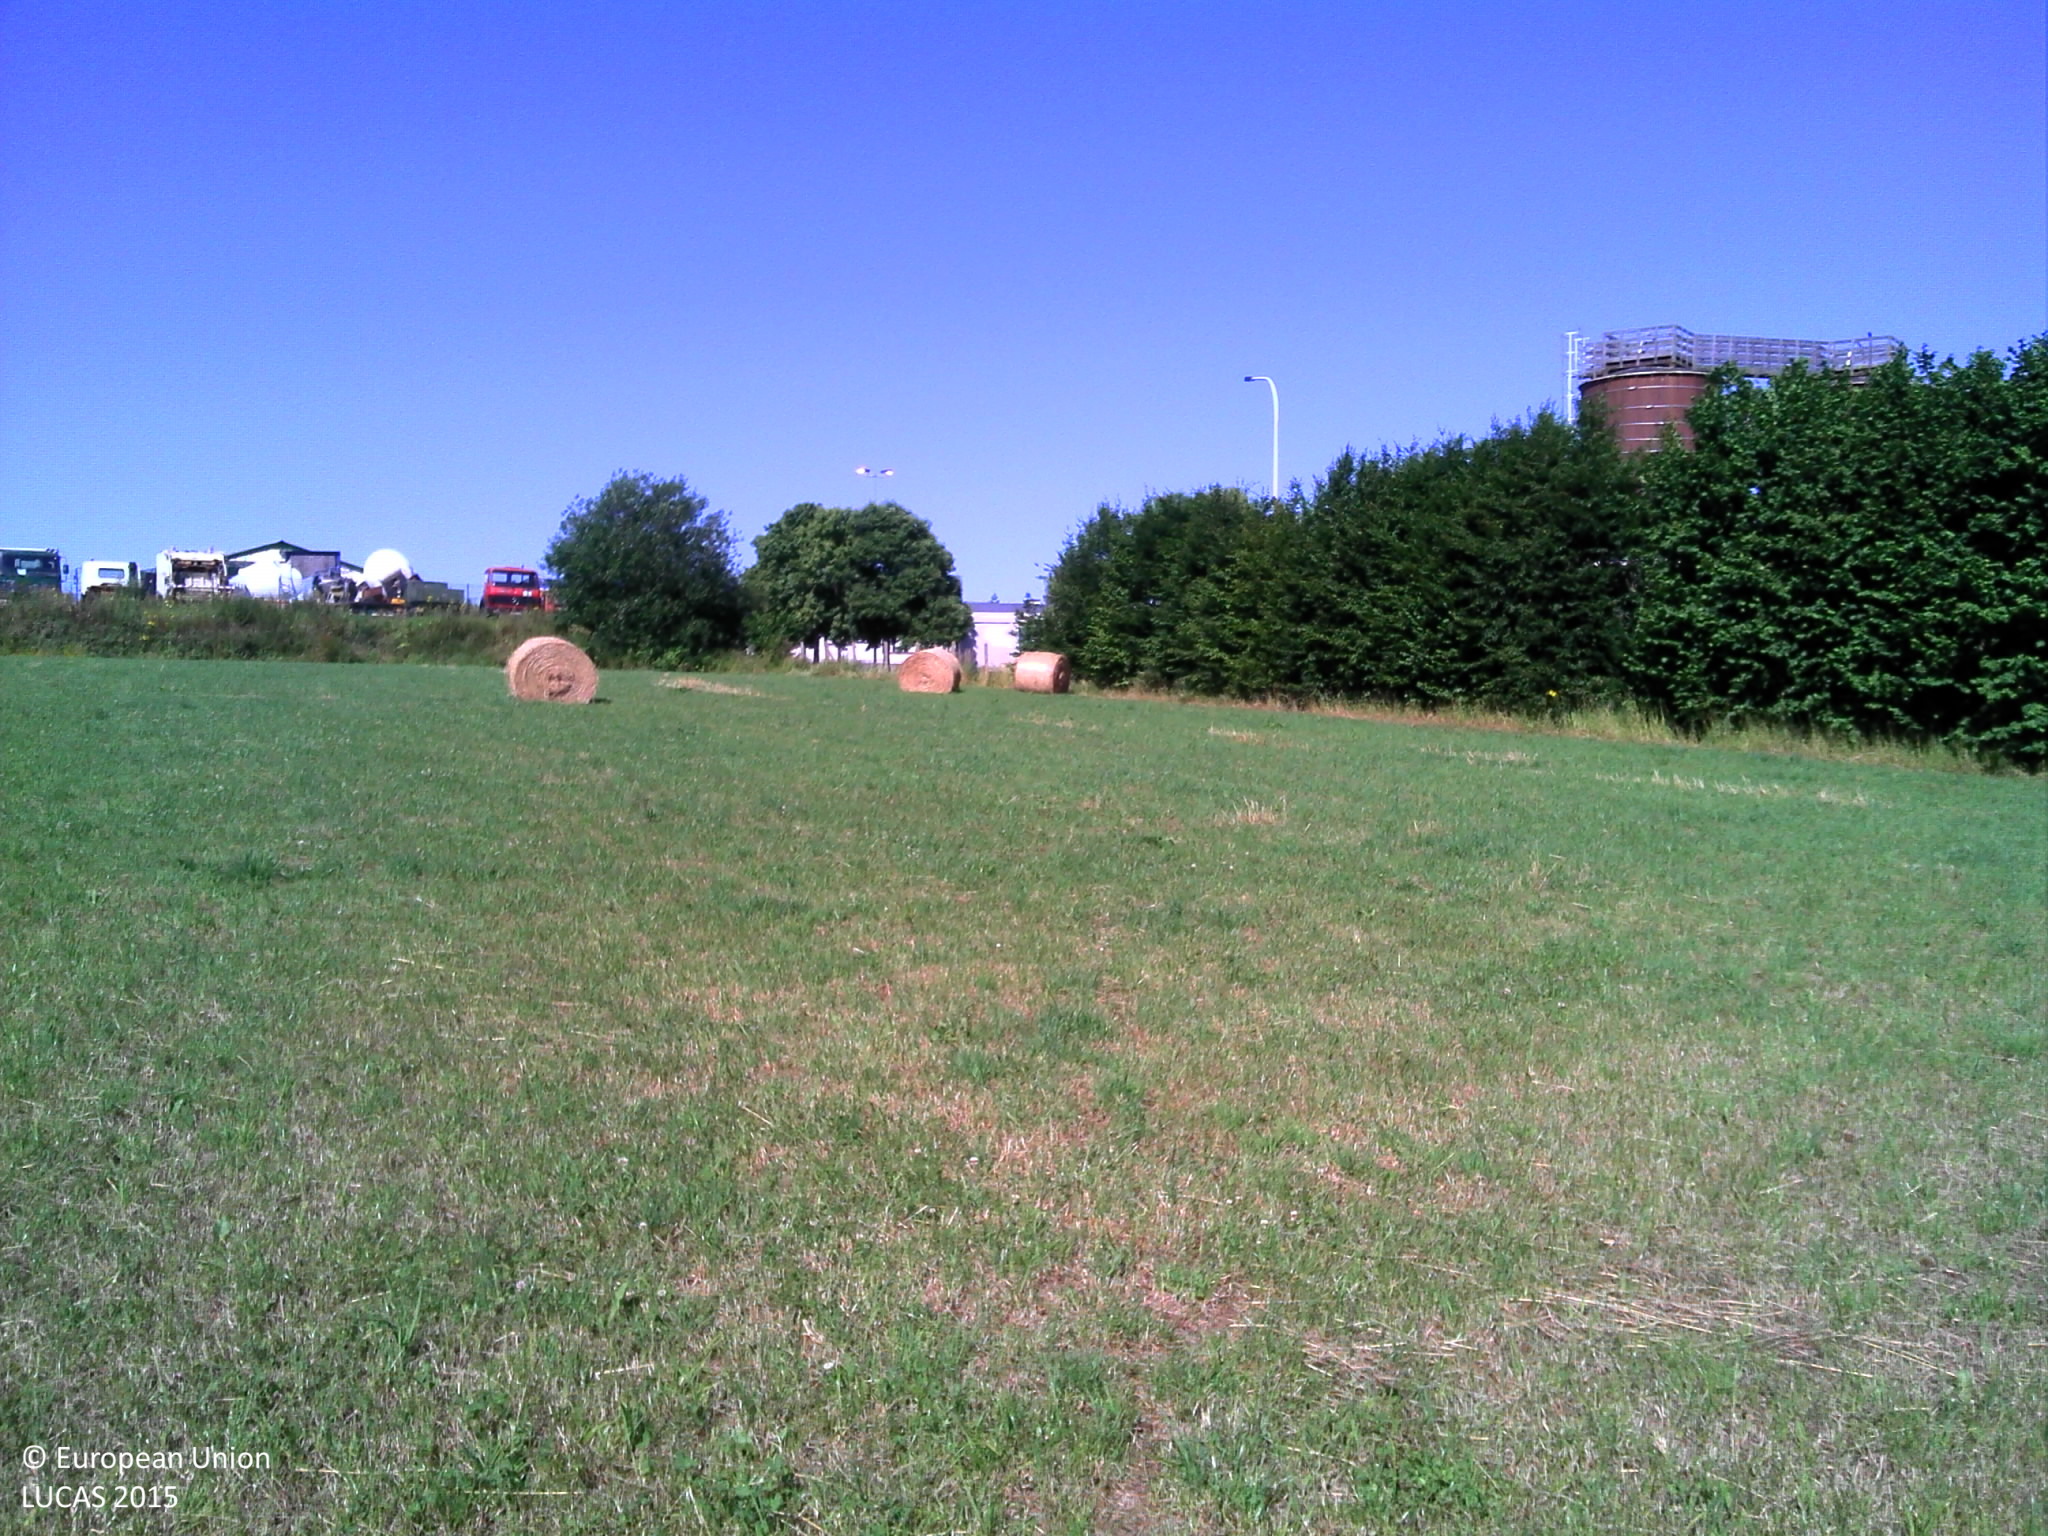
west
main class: Grassland
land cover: Grassland without tree/shrub cover
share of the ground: > 75 %
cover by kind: herbaceous plants 100 %
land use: Agriculture (excluding fallow land and kitchen gardens)
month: July
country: BE
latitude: 50.1604
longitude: 5.7854
